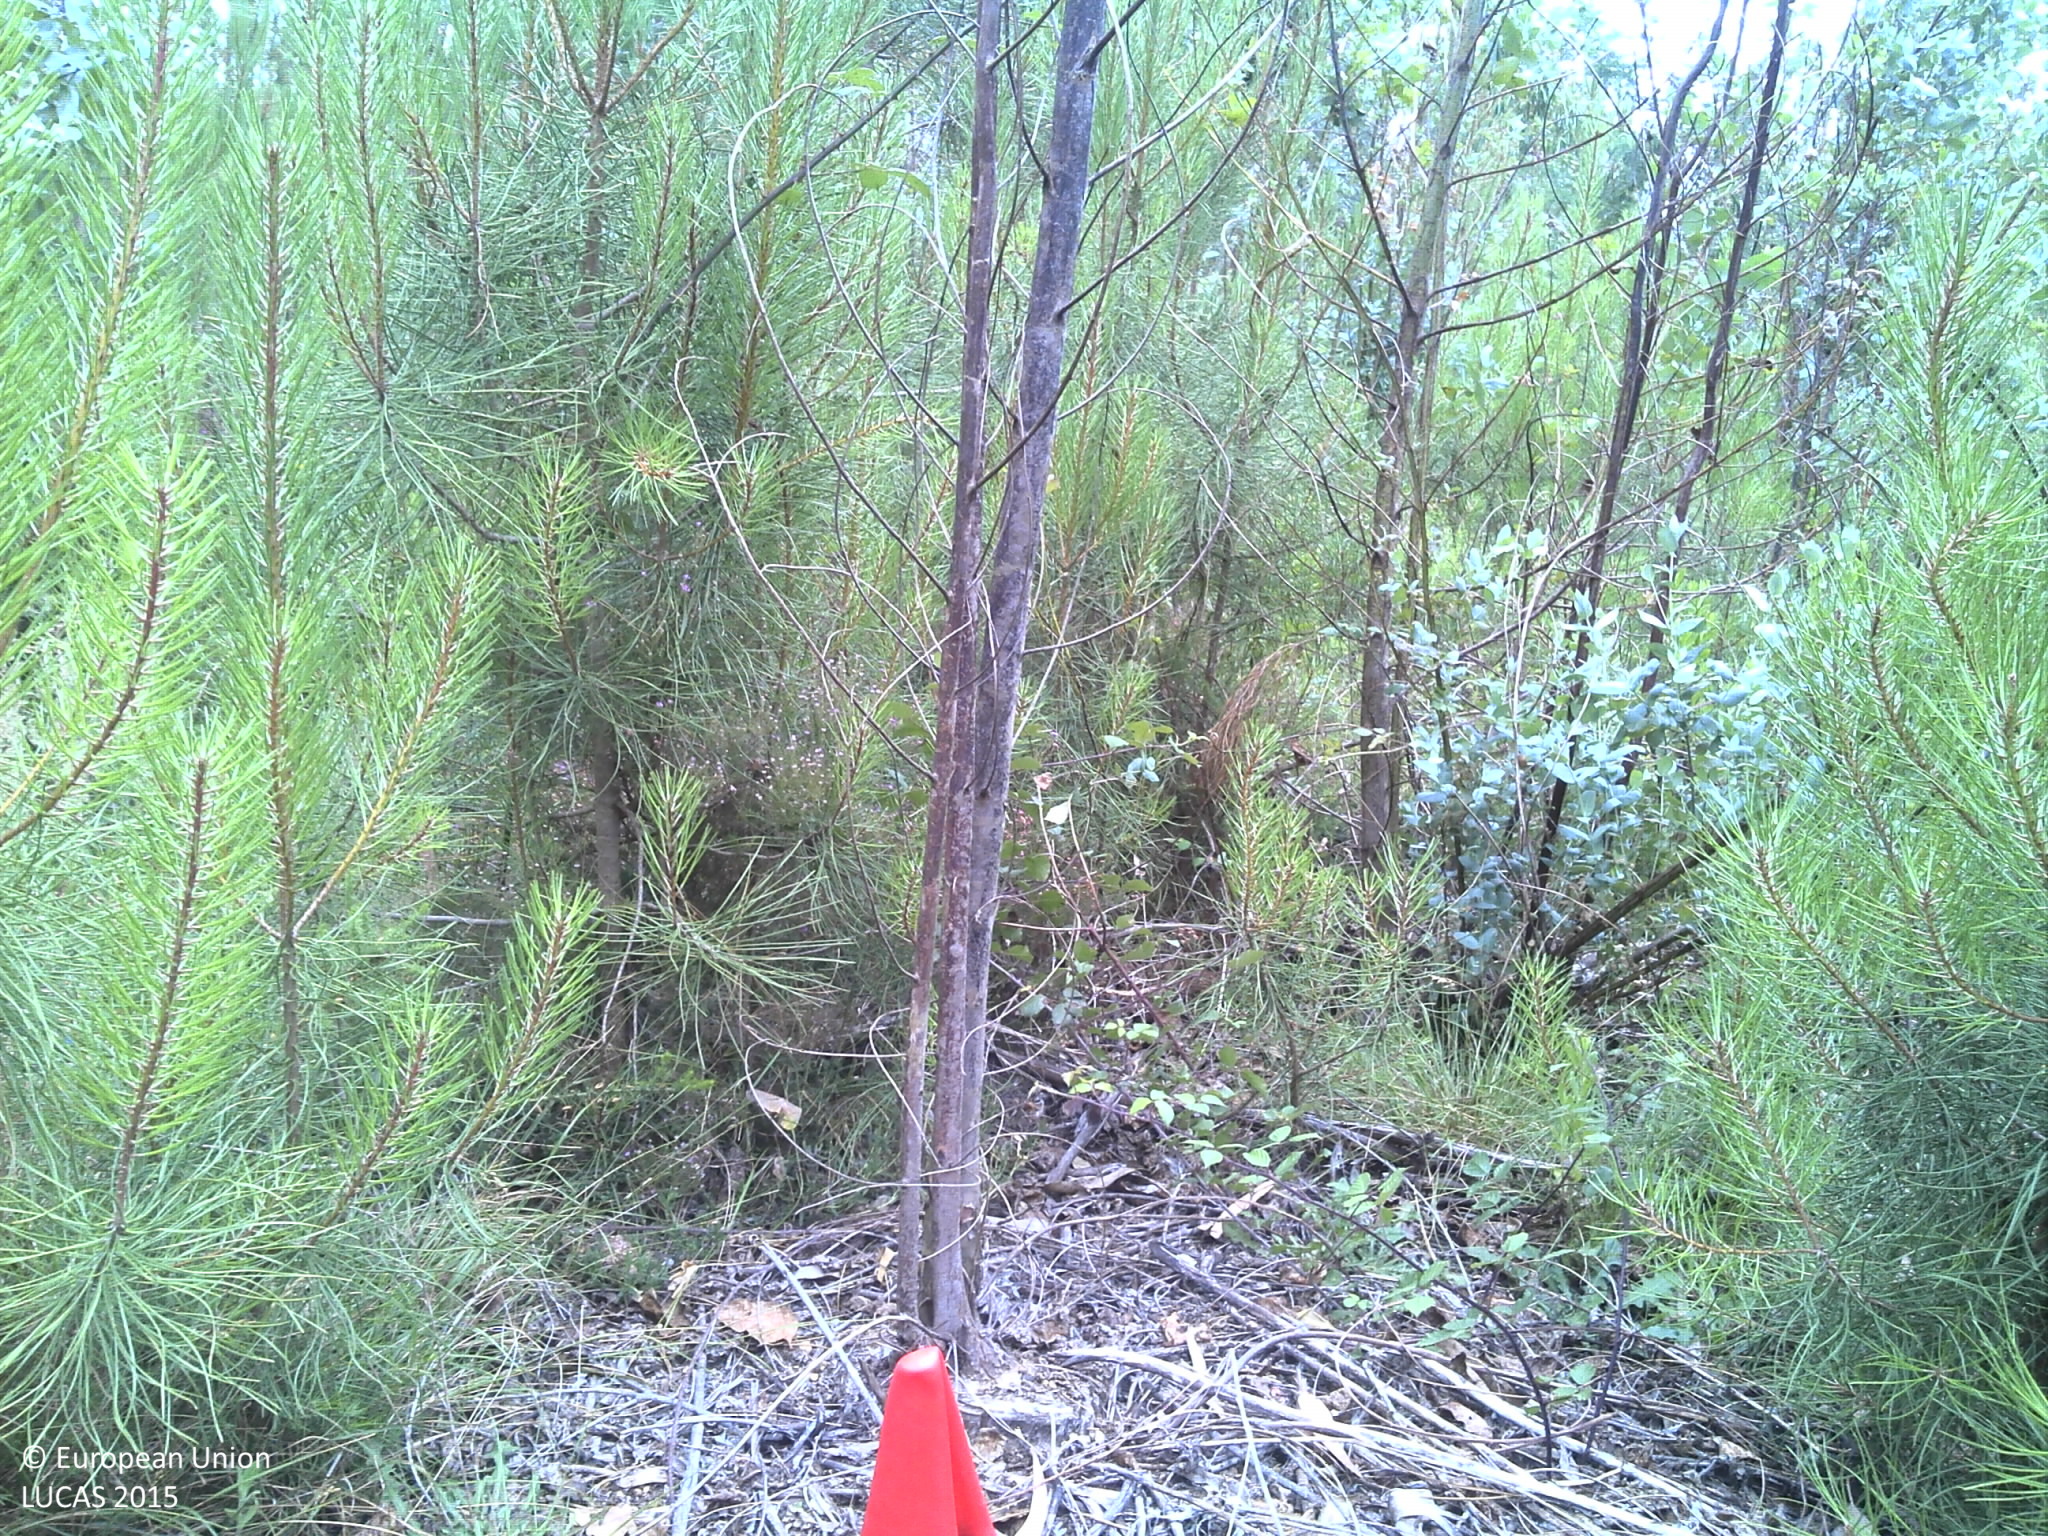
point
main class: Woodland
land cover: Broadleaved woodland
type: exotic forest
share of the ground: 50 - 75 %
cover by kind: broadleaved forest trees 70 %, shrubs 20 %, unconsolidated bare surface 10 %
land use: Forestry
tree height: > 5 m
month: June
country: PT
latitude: 40.2332
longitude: -8.6730
